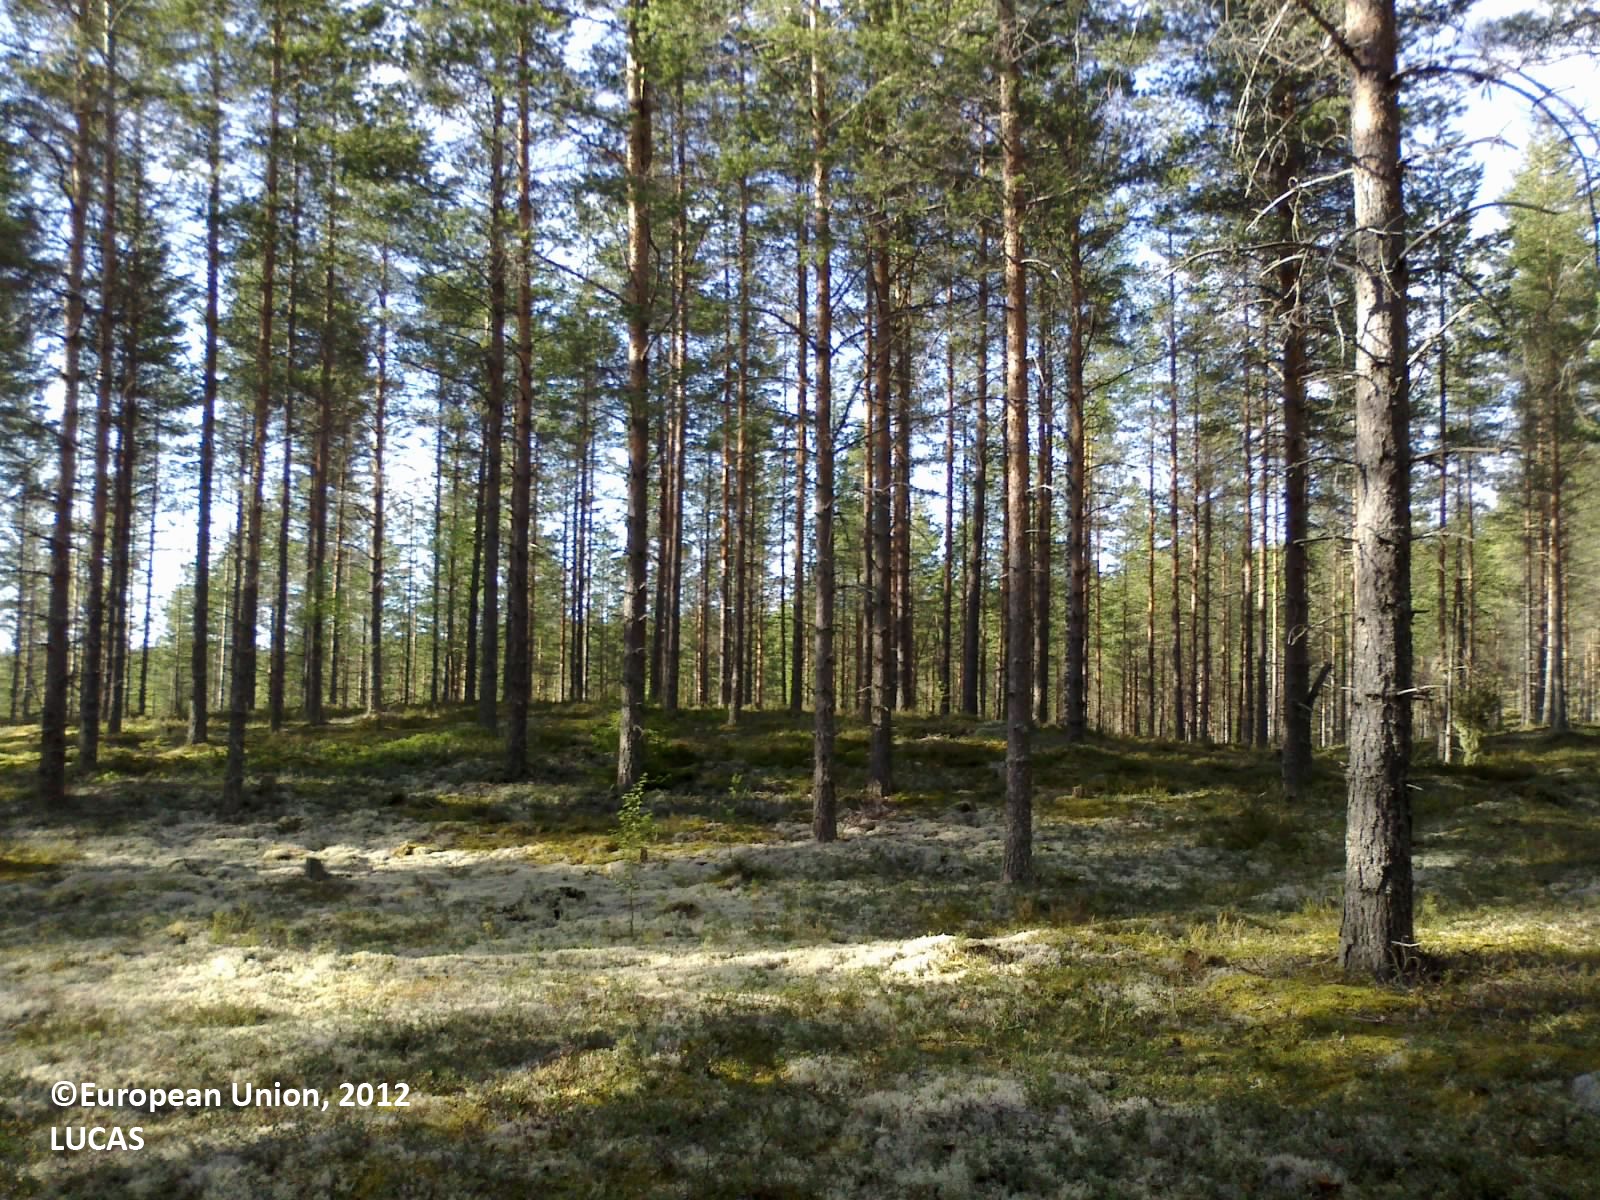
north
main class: Woodland
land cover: Pine dominated coniferous woodland
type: boreal forest
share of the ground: 50 - 75 %
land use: Forestry
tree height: > 5 m
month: May
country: FI
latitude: 62.4364
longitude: 25.4336
